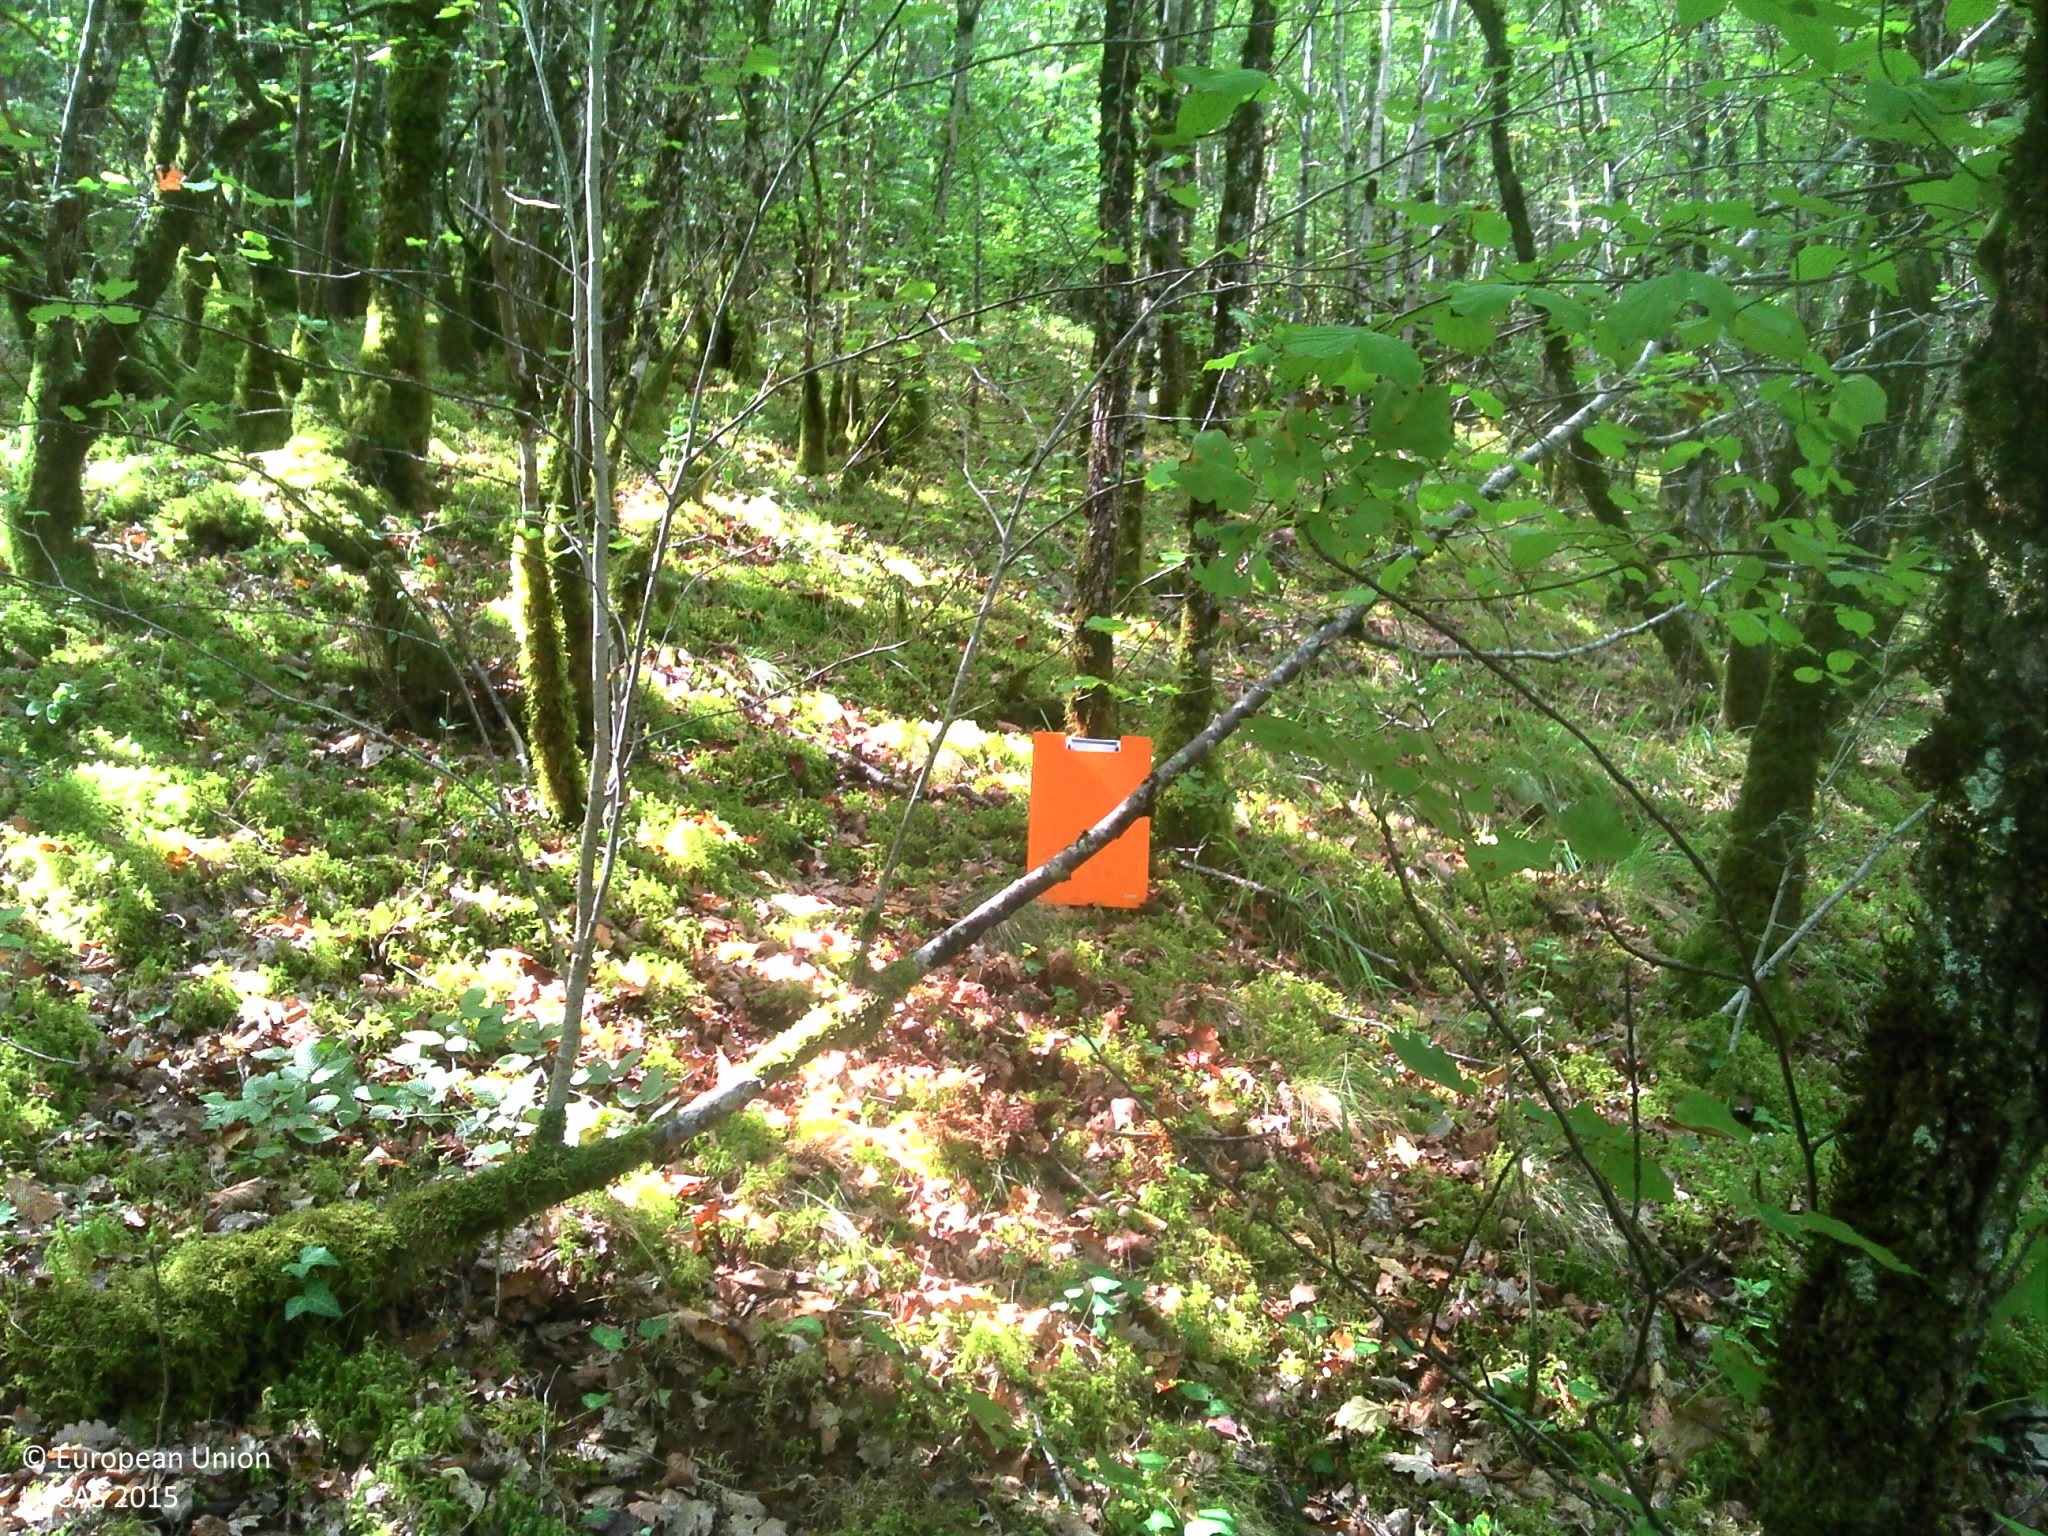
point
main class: Woodland
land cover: Broadleaved woodland
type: acidophilous oak and oak-birch forest
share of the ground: > 75 %
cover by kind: broadleaved forest trees 80 %, herbaceous plants 10 %, lichens and mosses 10 %
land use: Forestry
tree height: > 5 m
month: August
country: FR
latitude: 44.9211
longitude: 1.4447
